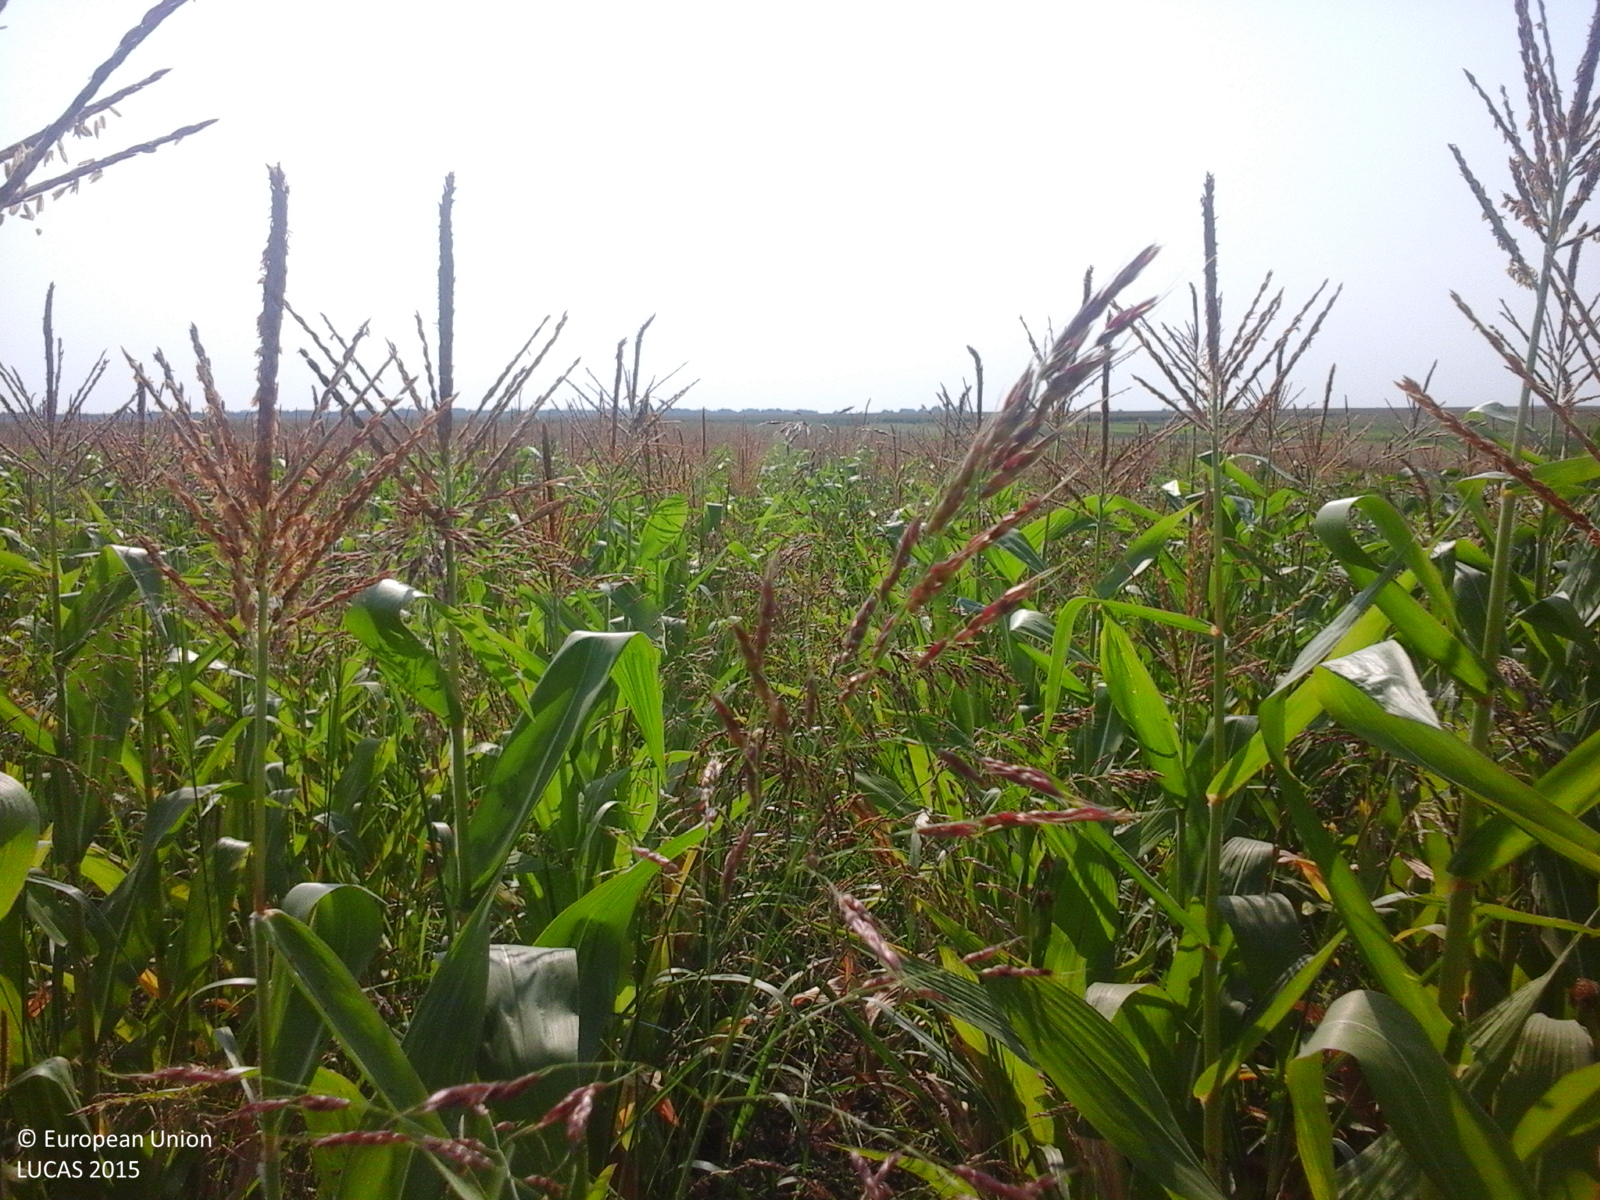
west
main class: Cropland
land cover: Maize
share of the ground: > 75 %
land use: Agriculture (excluding fallow land and kitchen gardens)
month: July
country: RO
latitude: 44.8868
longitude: 26.8801
